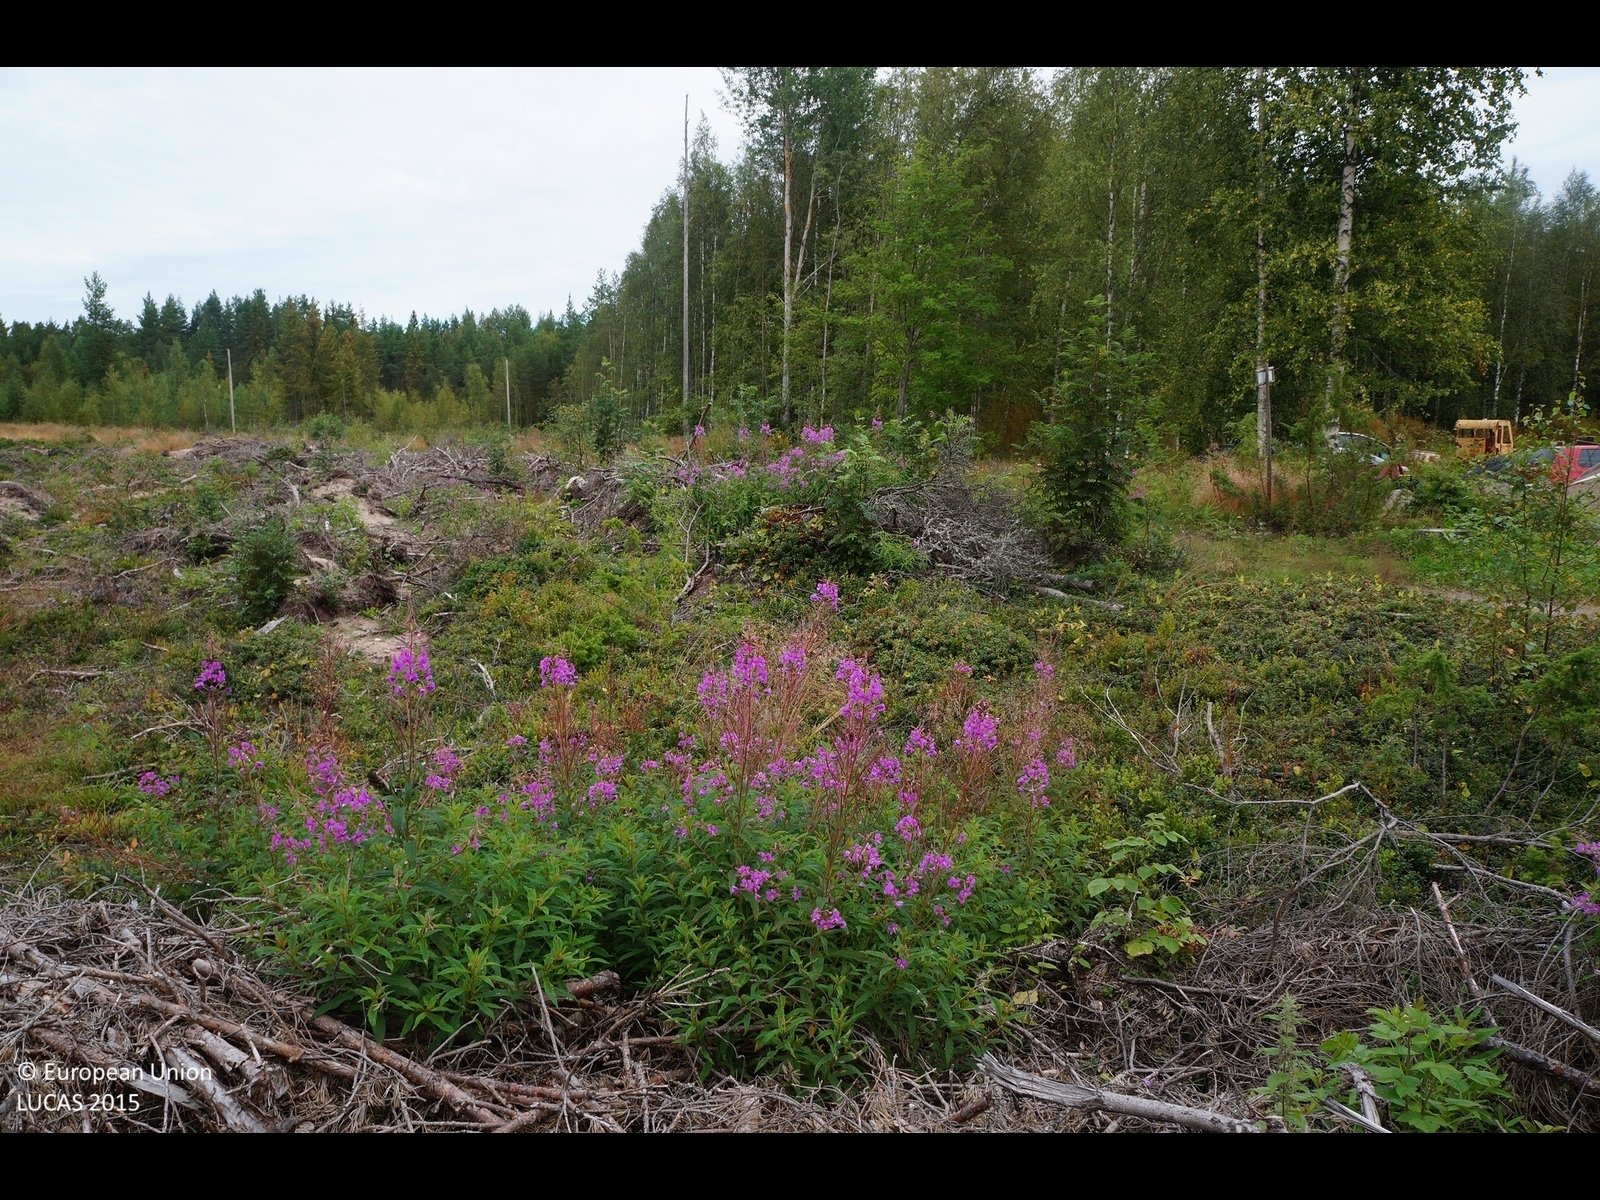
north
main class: Shrubland
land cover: Shrubland without tree cover
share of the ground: 25 - 50 %
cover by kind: shrubs 35 %, herbaceous plants 20 %, unconsolidated bare surface 10 %
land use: Forestry
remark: Clear cut
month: August
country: FI
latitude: 64.7879
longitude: 25.3799
